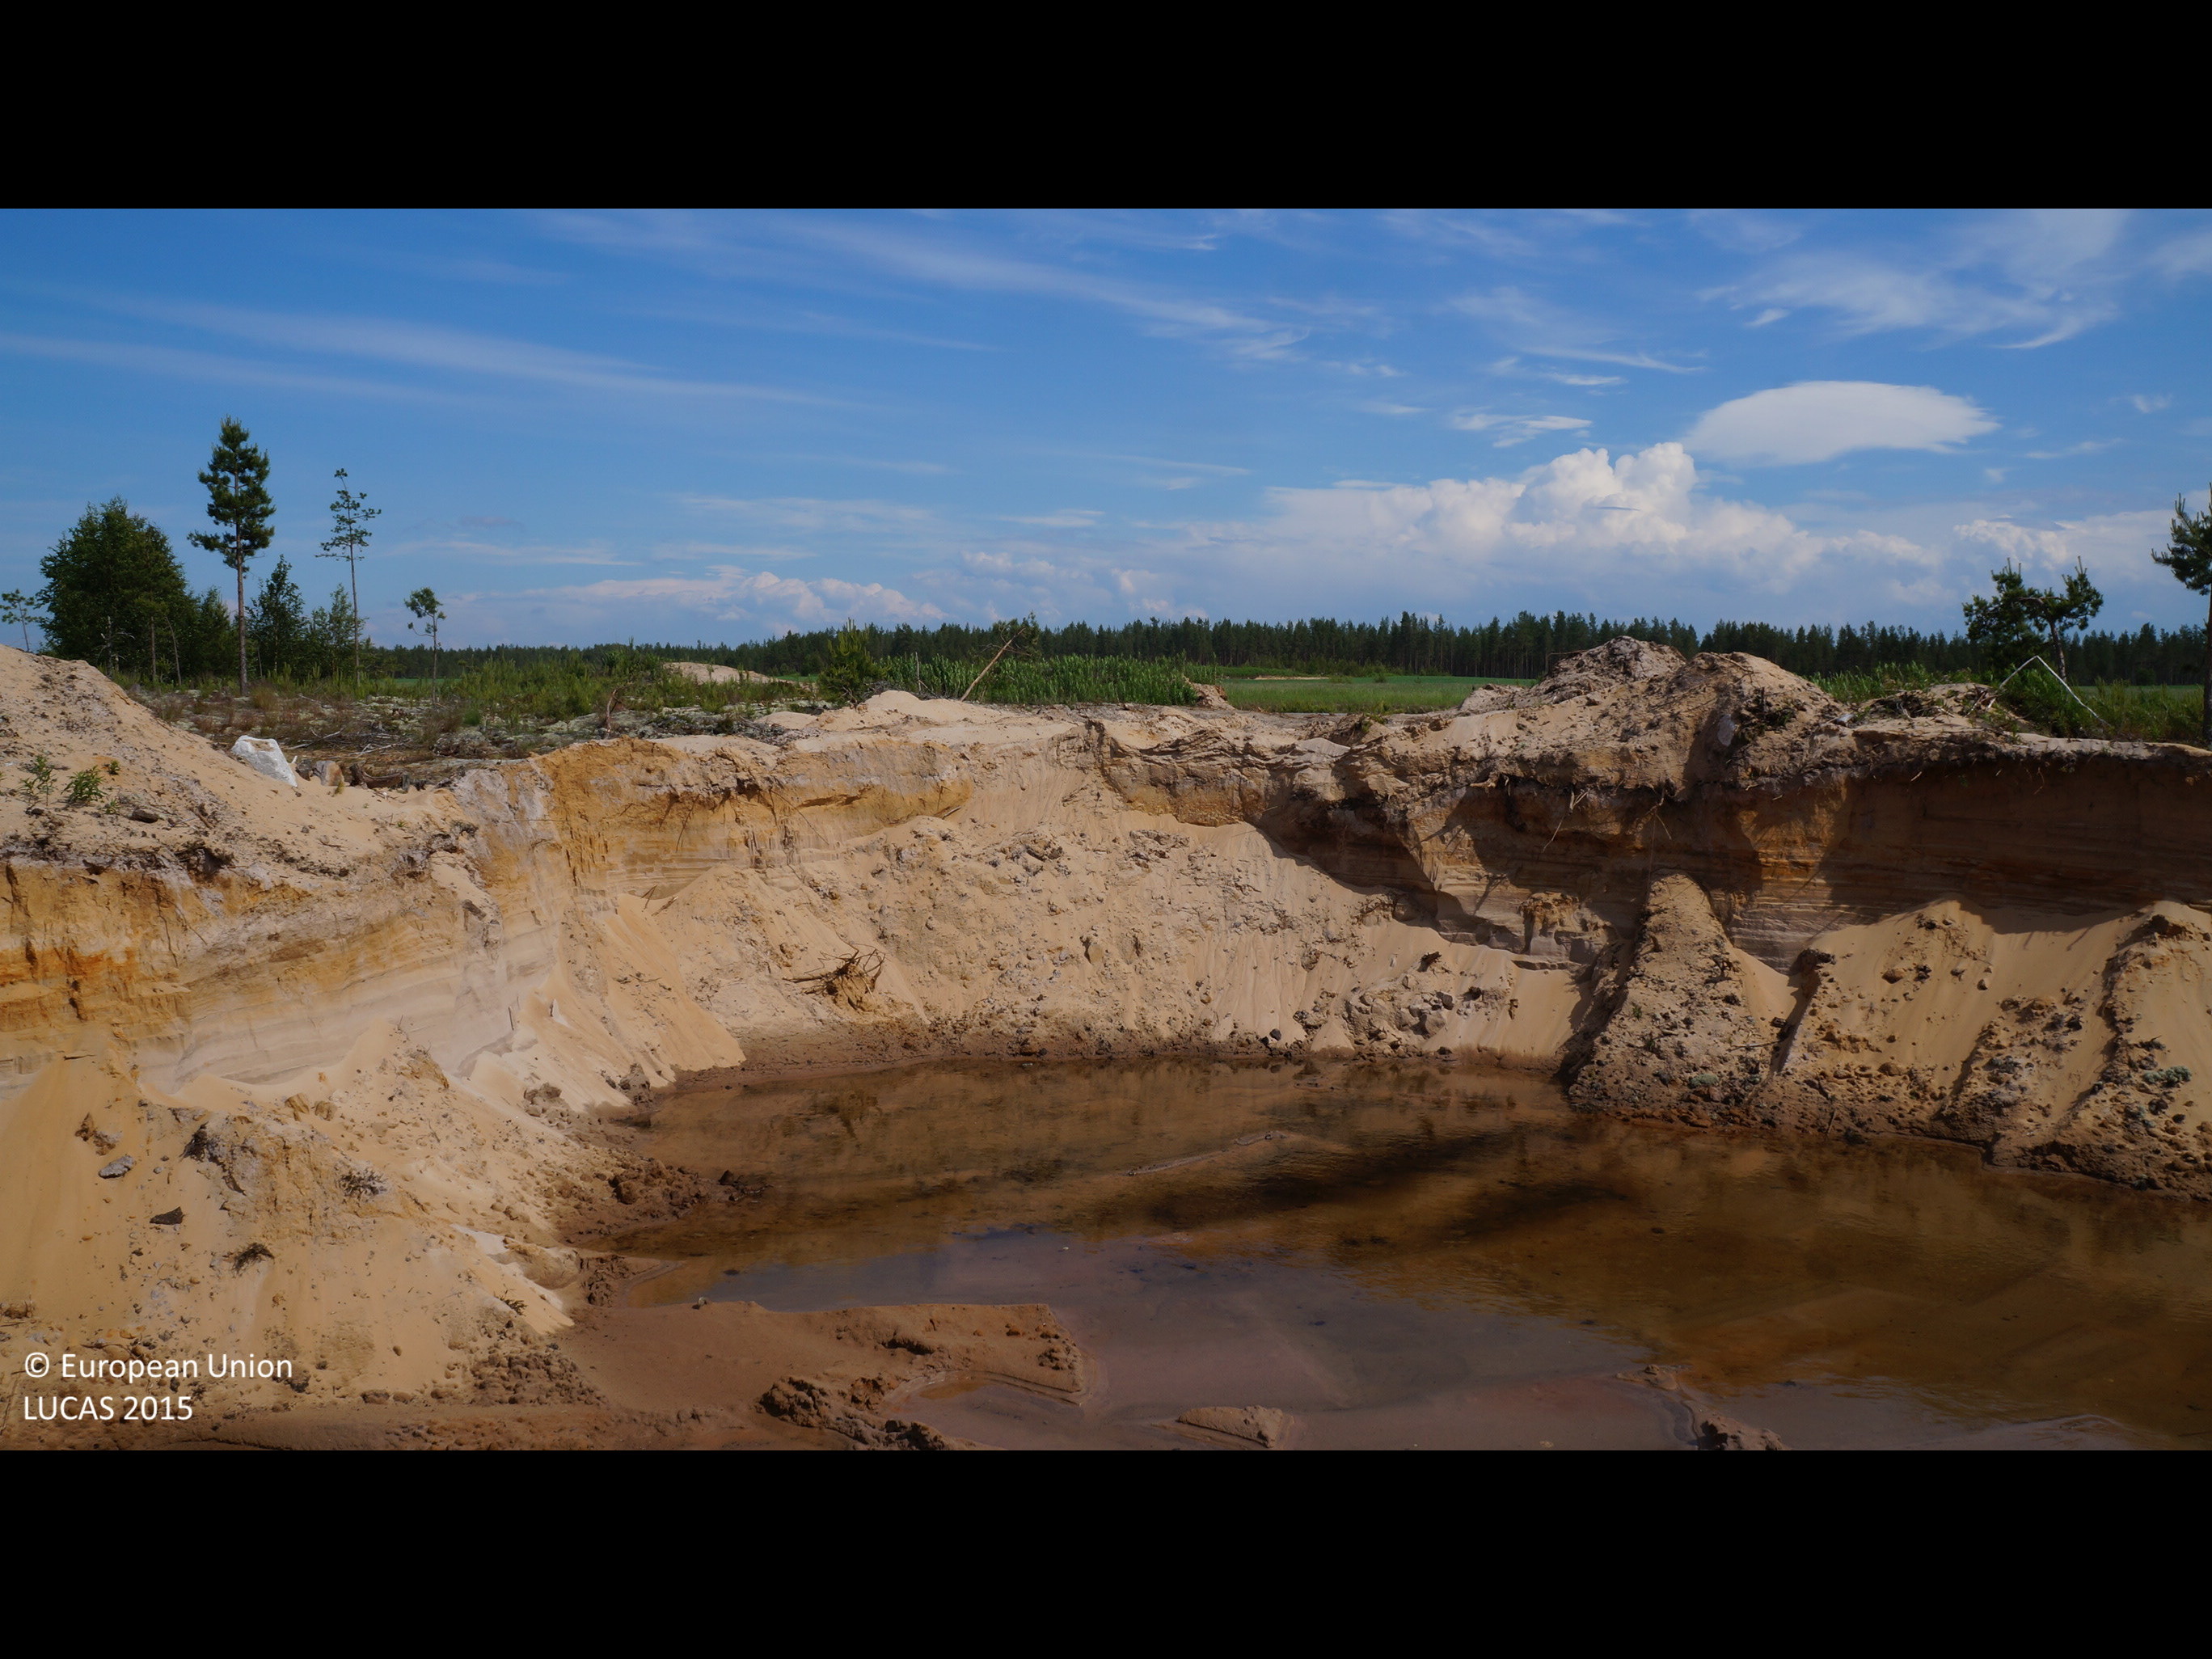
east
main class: Cropland
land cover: Common wheat
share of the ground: > 75 %
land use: Agriculture (excluding fallow land and kitchen gardens)
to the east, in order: Common wheat; Sand; Lichens and moss; Sand; Tracks; Sand; Ditches and canals; Sand; Temporary grasslands; Ditches and canals; Shruby margins; Ditches and canals; Shruby margins; Temporary grasslands
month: June
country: FI
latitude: 64.1508
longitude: 23.8967
